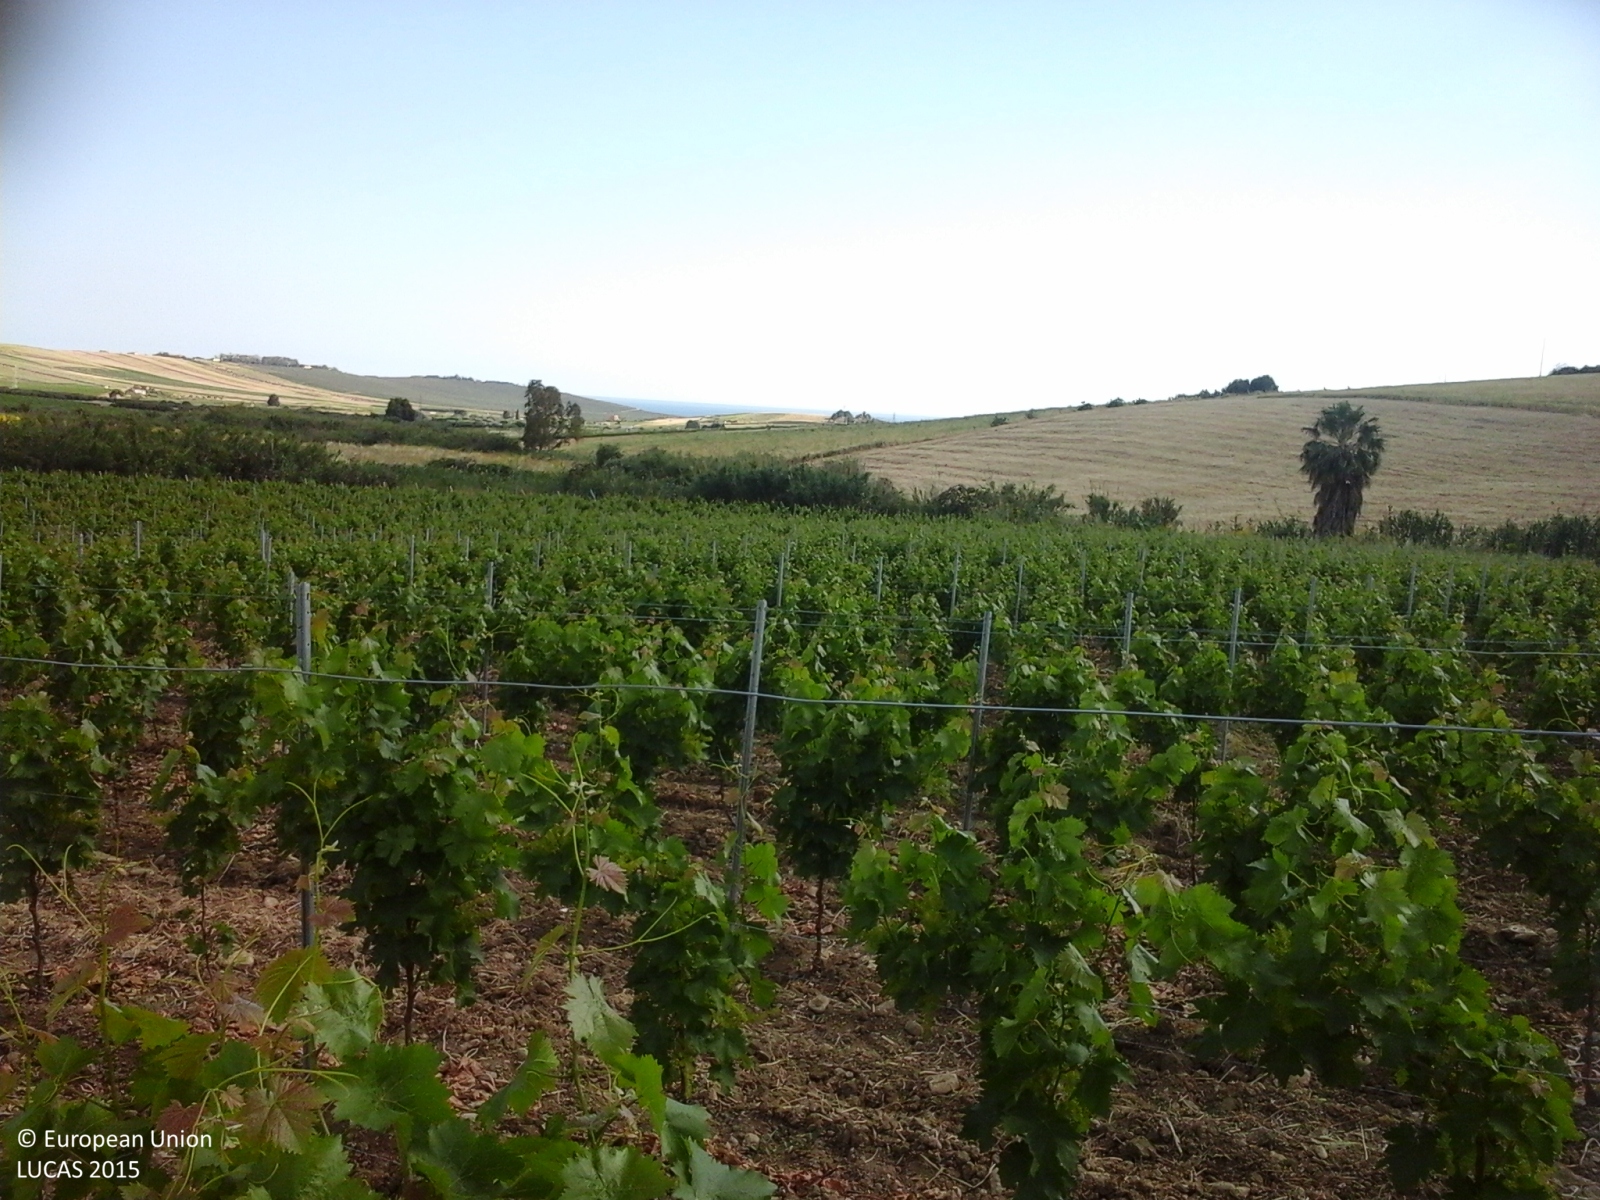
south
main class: Cropland
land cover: Vineyards
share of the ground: 10 - 25 %
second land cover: Other bare soil
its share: > 75 %
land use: Agriculture (excluding fallow land and kitchen gardens)
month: May
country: IT
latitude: 37.5919
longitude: 12.9785
